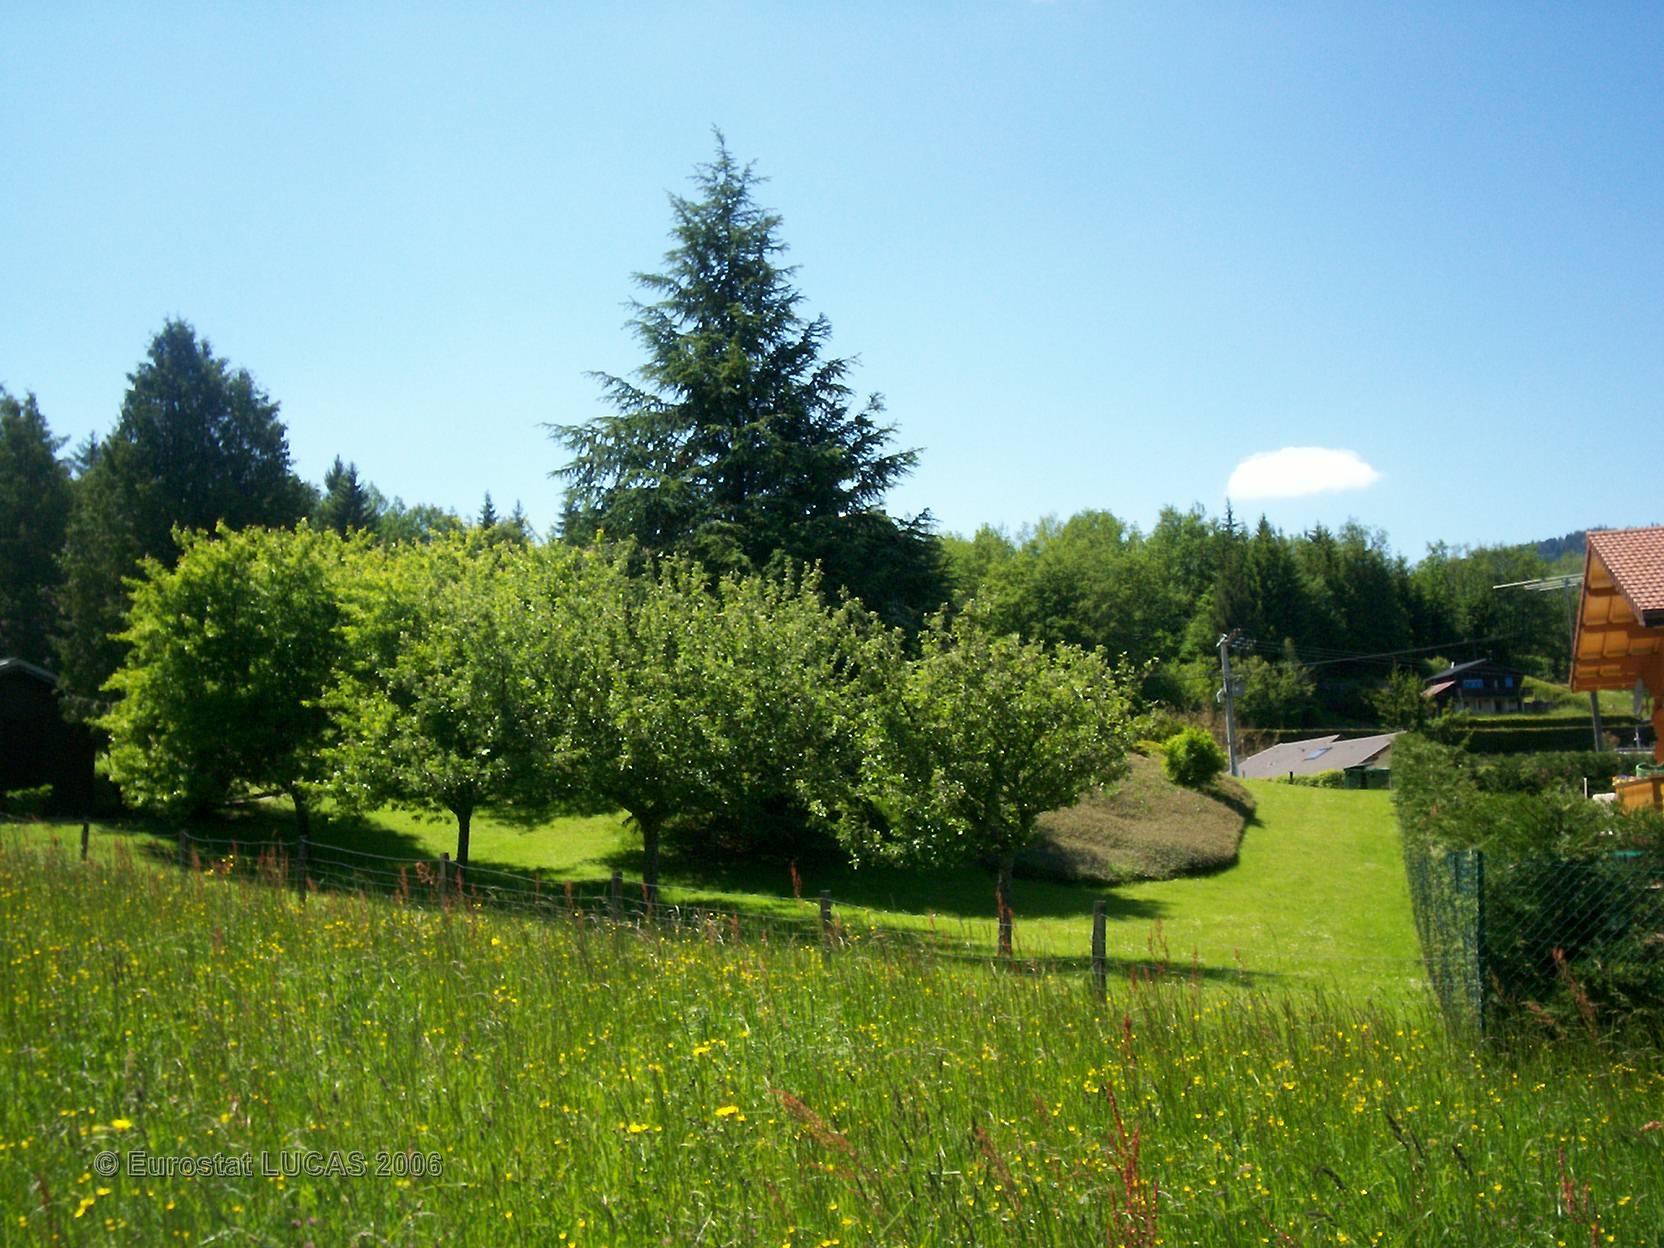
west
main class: Grassland
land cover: Grassland without tree/shrub cover
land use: Agriculture (excluding fallow land and kitchen gardens)
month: June
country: FR
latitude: 46.1821
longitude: 6.3891
